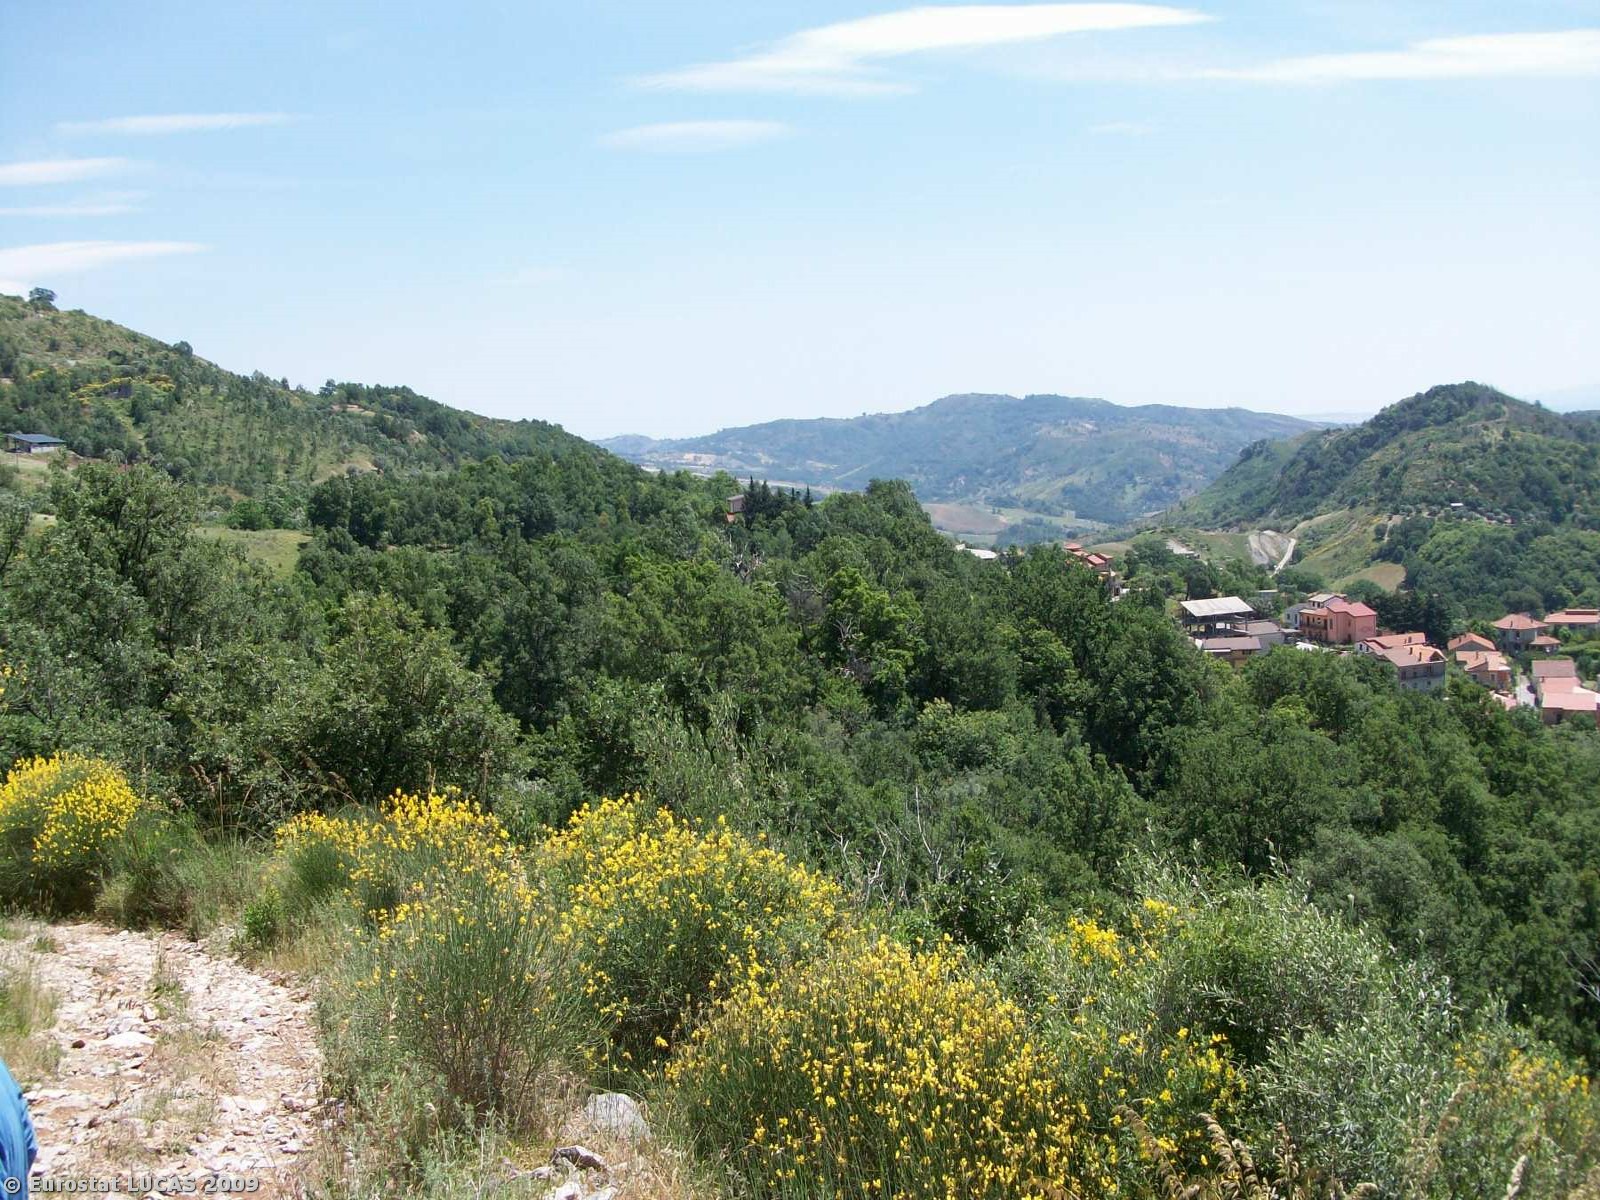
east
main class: Shrubland
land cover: Shrubland without tree cover
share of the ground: 50 - 75 %
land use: Nature reserves
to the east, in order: Shrubland without tree cover; Paved roads, cycling and walking lanes; Broadleaved woodland; Paved roads, cycling and walking lanes; Broadleaved woodland; Paved roads, cycling and walking lanes; Broadleaved woodland
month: June
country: IT
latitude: 39.6648
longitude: 16.0218
